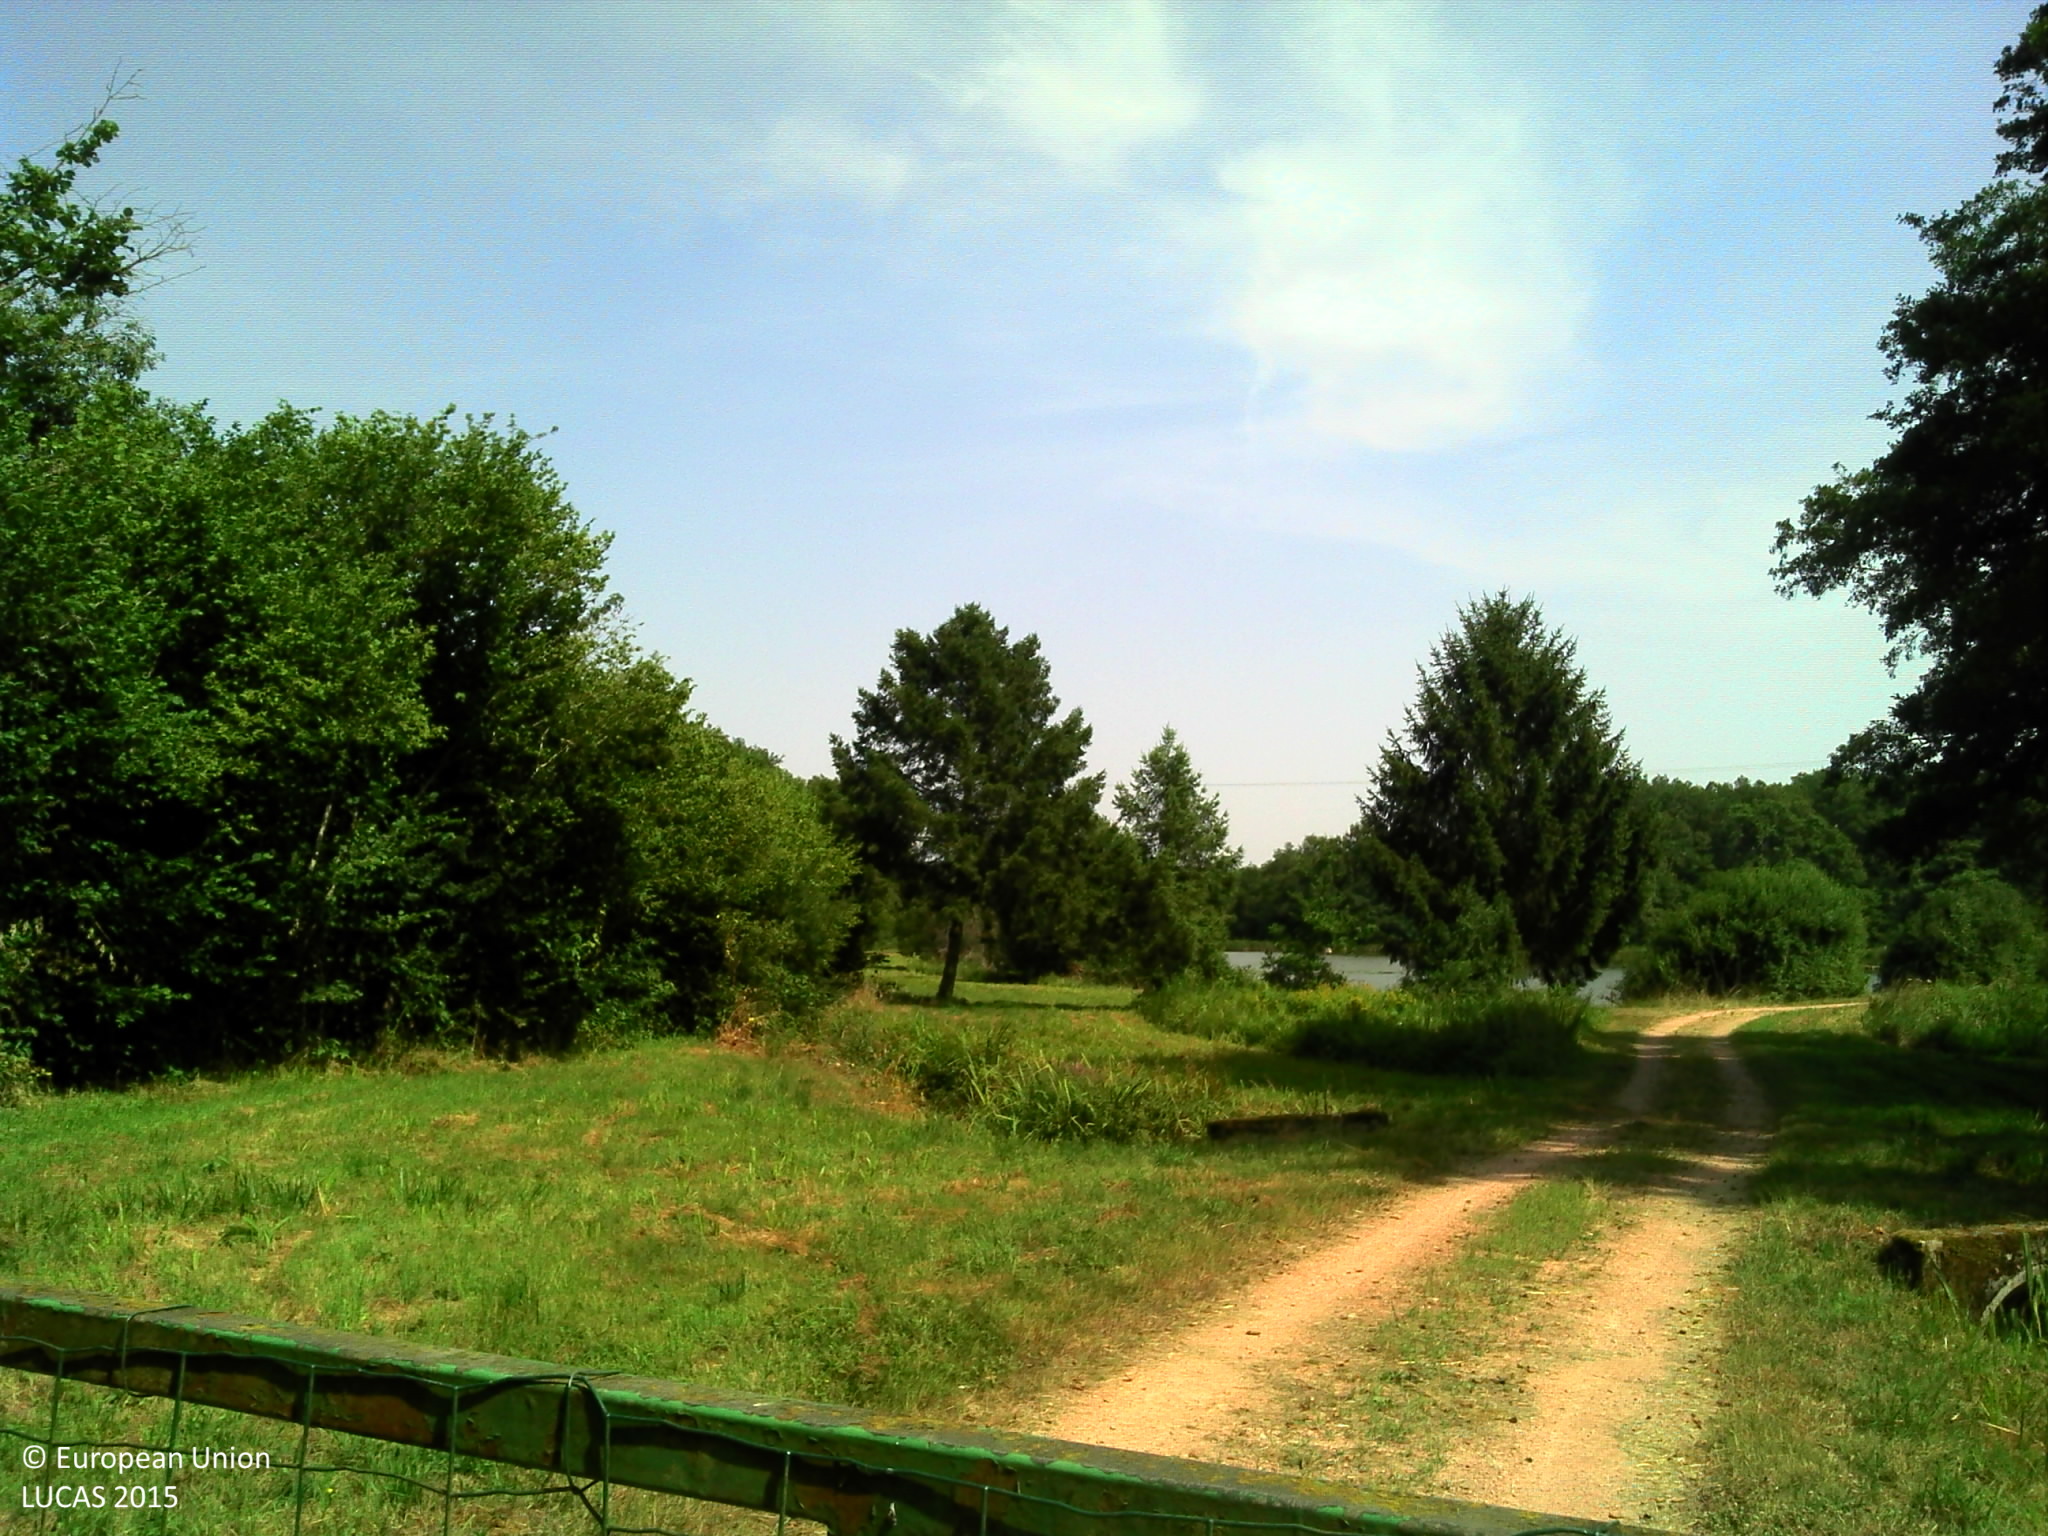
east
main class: Grassland
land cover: Grassland without tree/shrub cover
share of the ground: > 75 %
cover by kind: herbaceous plants 100 %
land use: Agriculture (excluding fallow land and kitchen gardens)
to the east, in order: Grassland without tree/shrub cover; Managed hedges; Electric lines; Fences; Grassland without tree/shrub cover; Fences; Broadleaved woodland
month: July
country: FR
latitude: 47.0407
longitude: 3.5354
